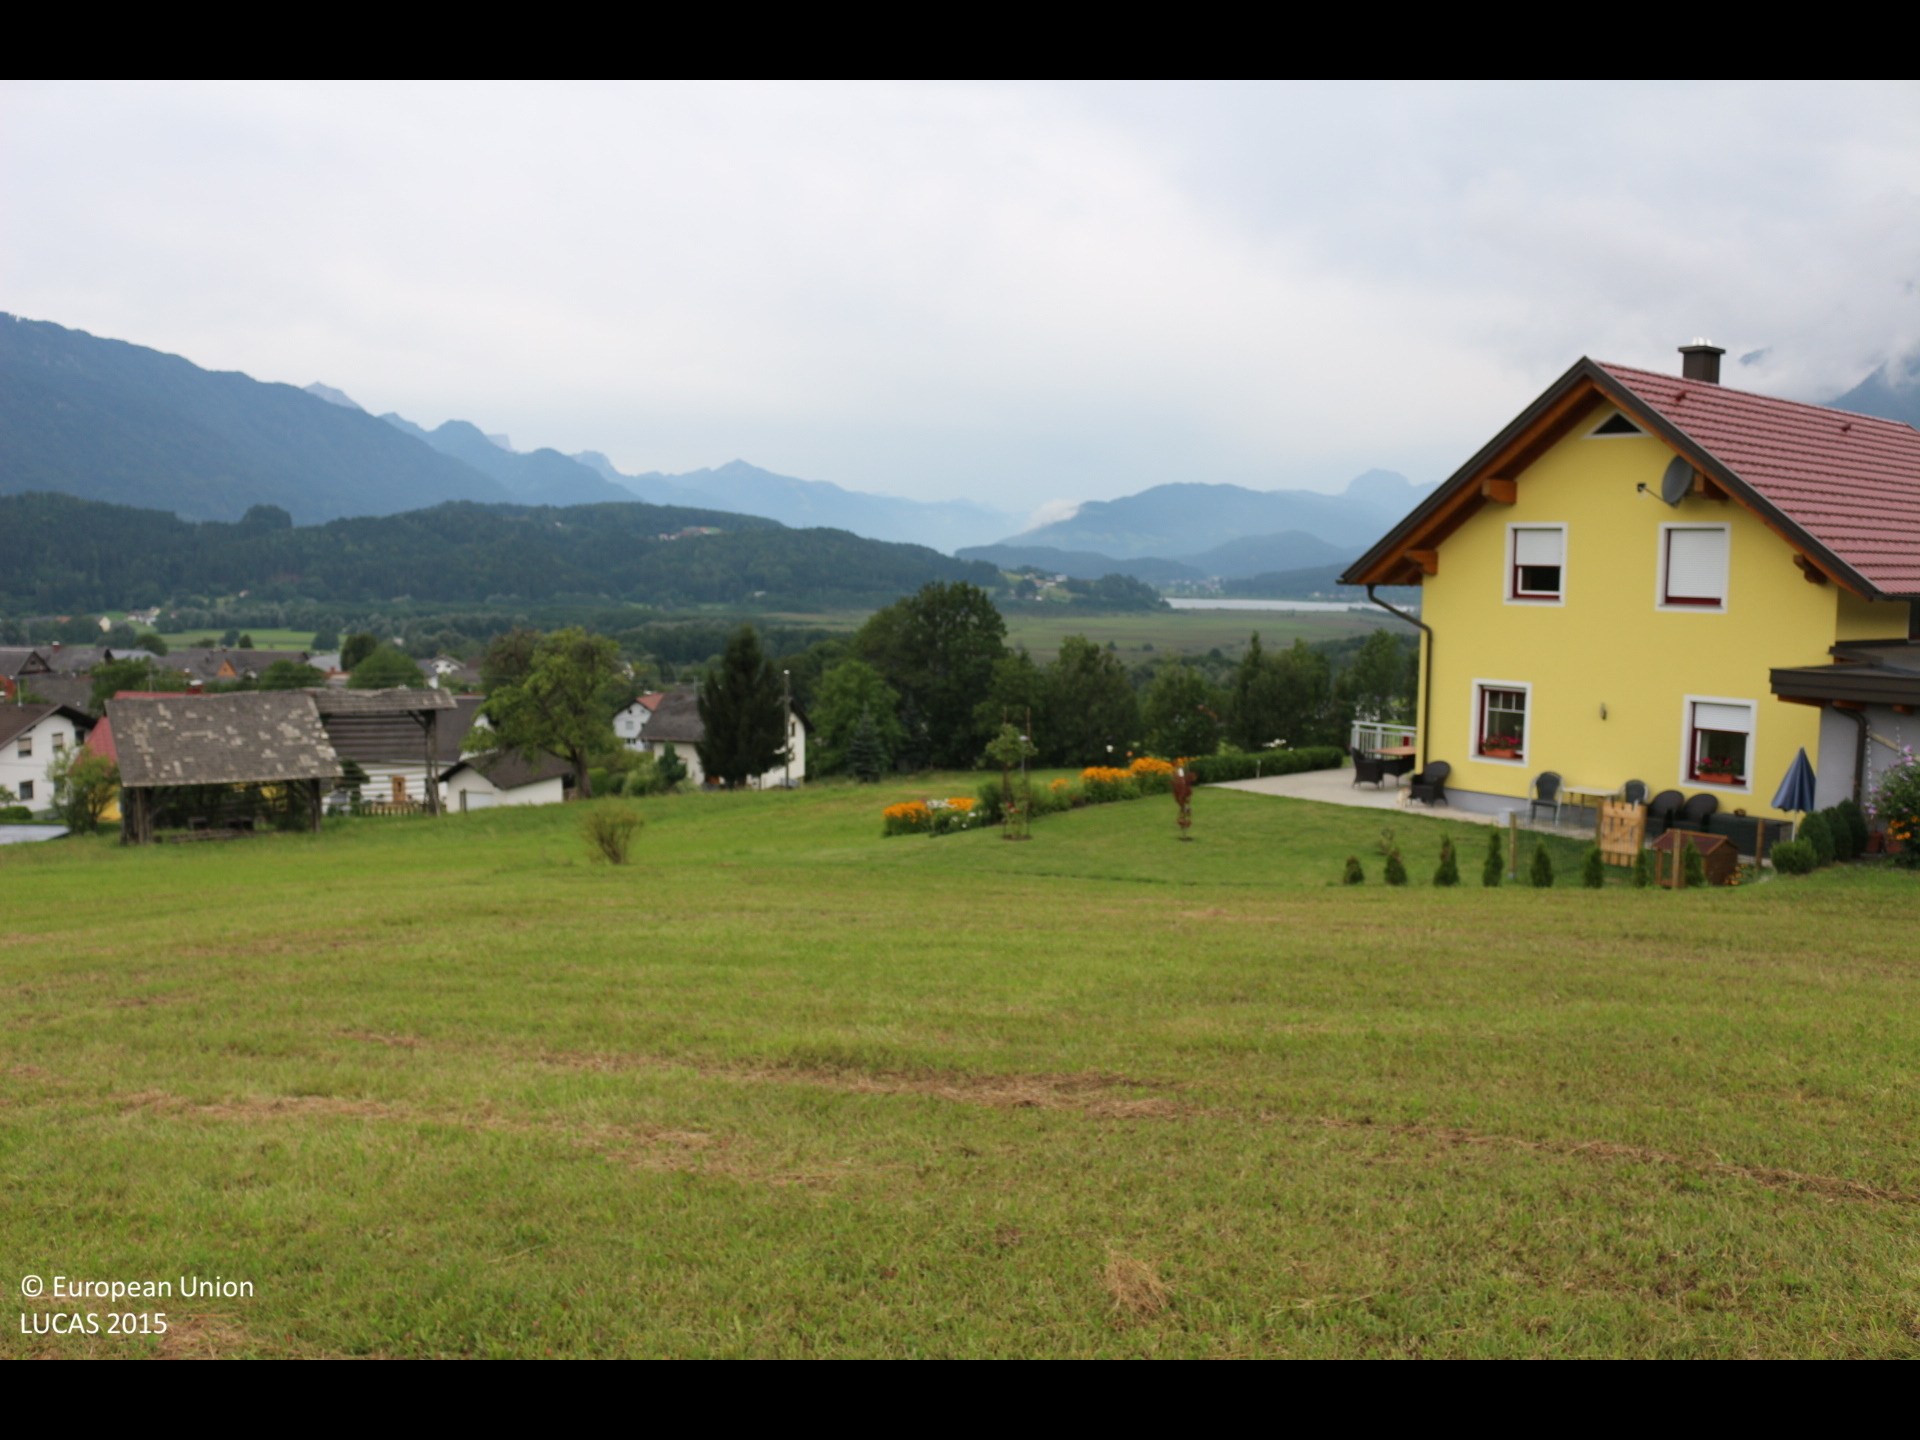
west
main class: Grassland
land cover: Grassland without tree/shrub cover
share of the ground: > 75 %
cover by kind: herbaceous plants 100 %
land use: Agriculture (excluding fallow land and kitchen gardens)
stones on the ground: < 10 %
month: August
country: AT
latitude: 46.6190
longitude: 13.4838
